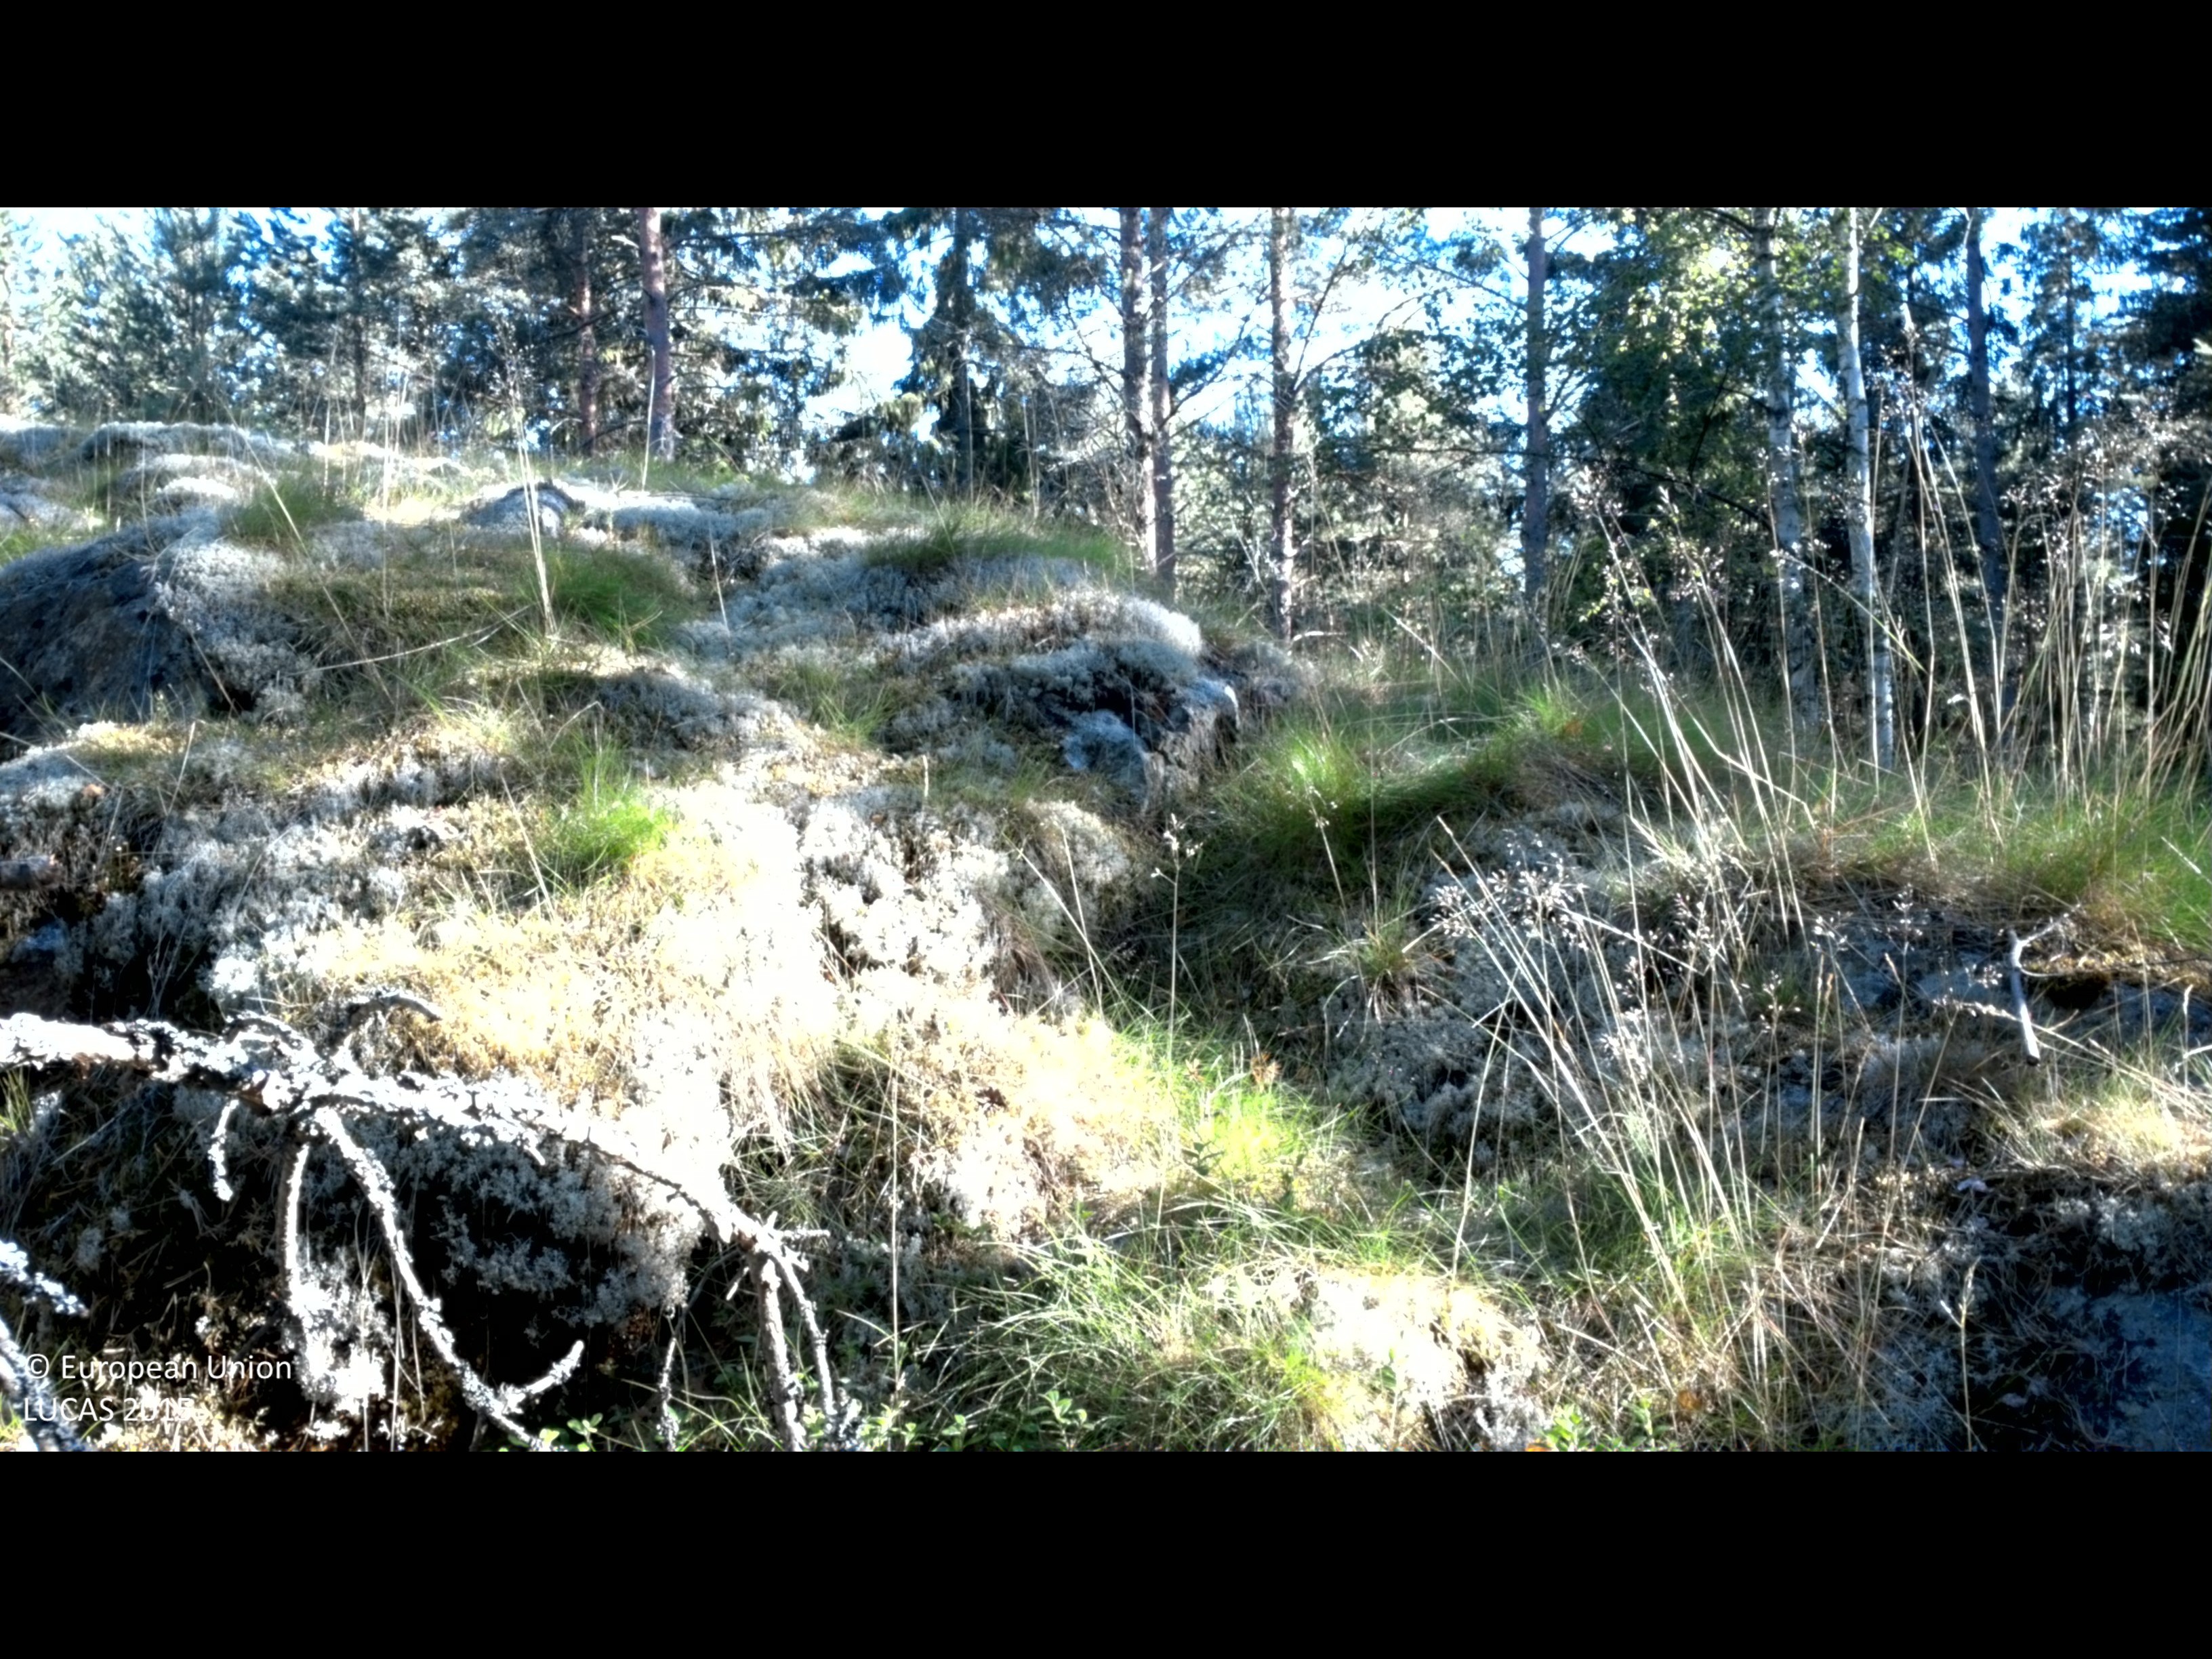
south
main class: Woodland
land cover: Pine dominated coniferous woodland
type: boreal forest
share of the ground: 50 - 75 %
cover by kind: coniferous forest trees 50 %, shrubs 20 %, lichens and mosses 15 %, broadleaved forest trees 10 %, herbaceous plants 5 %
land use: Forestry
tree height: > 5 m
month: July
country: SE
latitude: 58.2514
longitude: 16.6938
